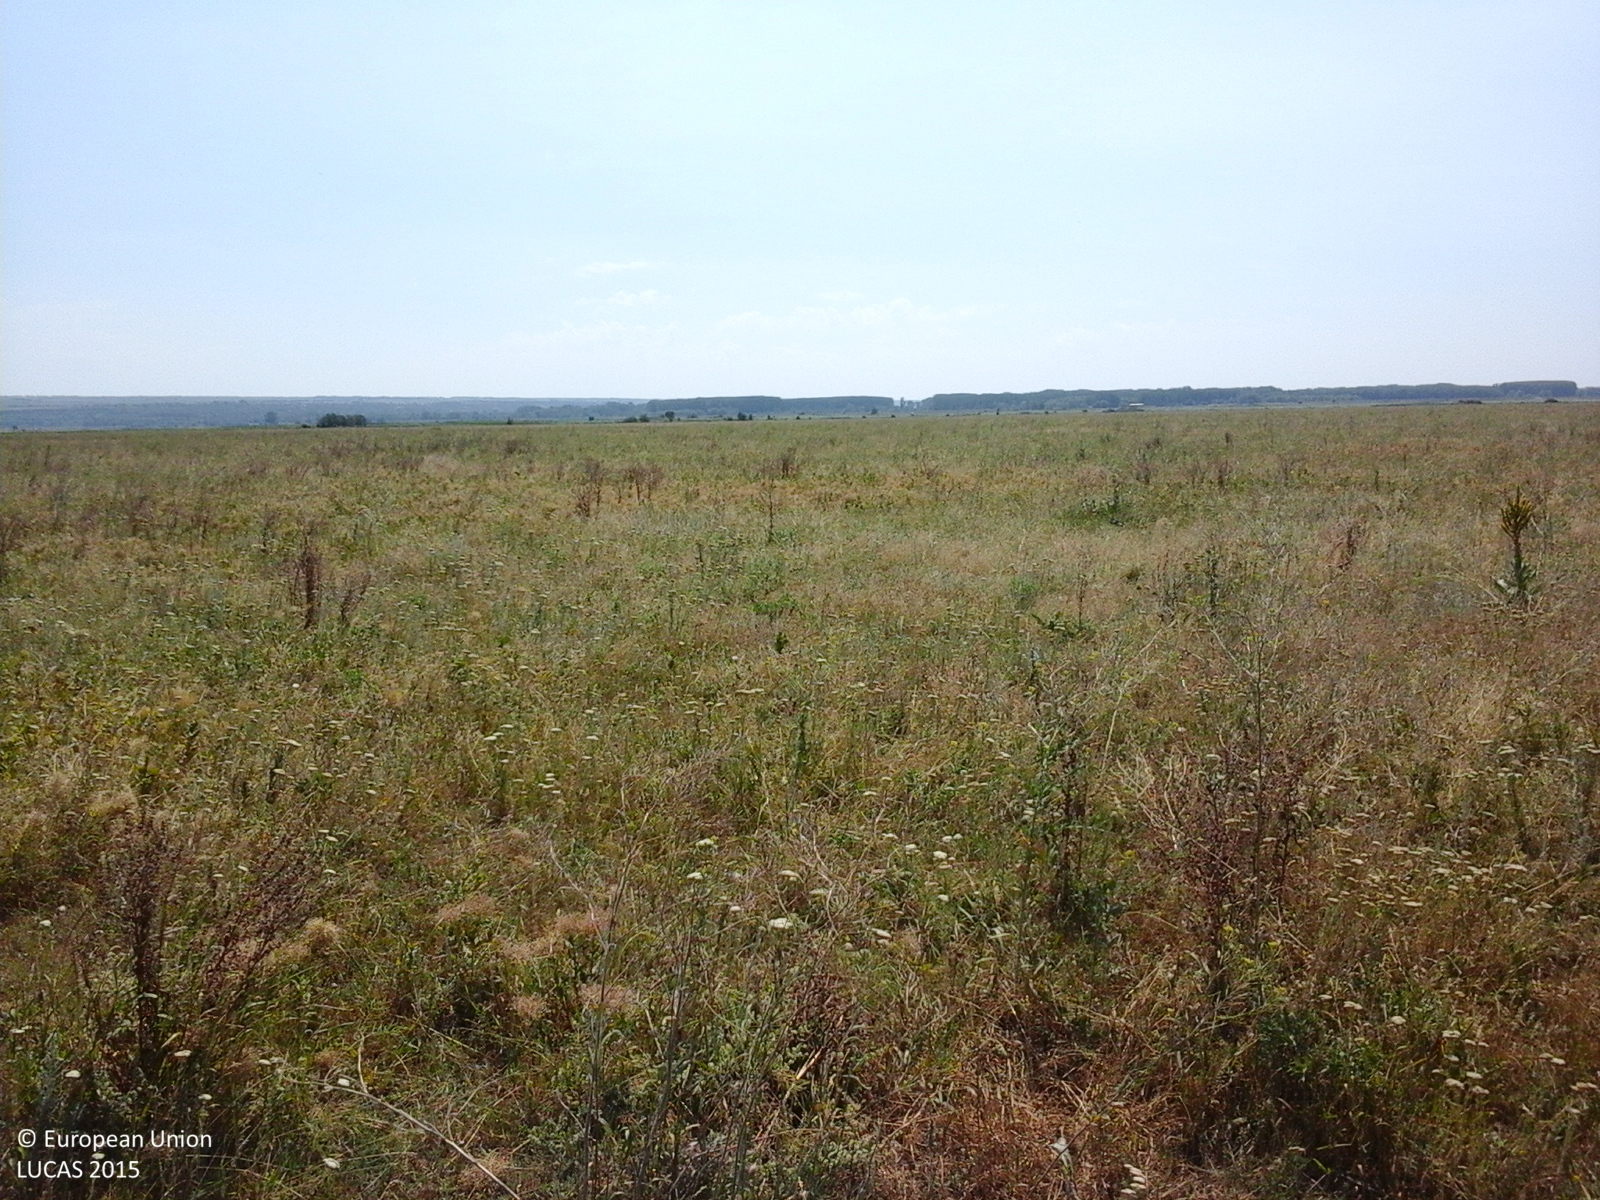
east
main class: Grassland
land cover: Grassland without tree/shrub cover
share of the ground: > 75 %
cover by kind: herbaceous plants 100 %
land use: Agriculture (excluding fallow land and kitchen gardens)
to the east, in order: Grassland without tree/shrub cover
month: June
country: RO
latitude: 46.9185
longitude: 28.0558
